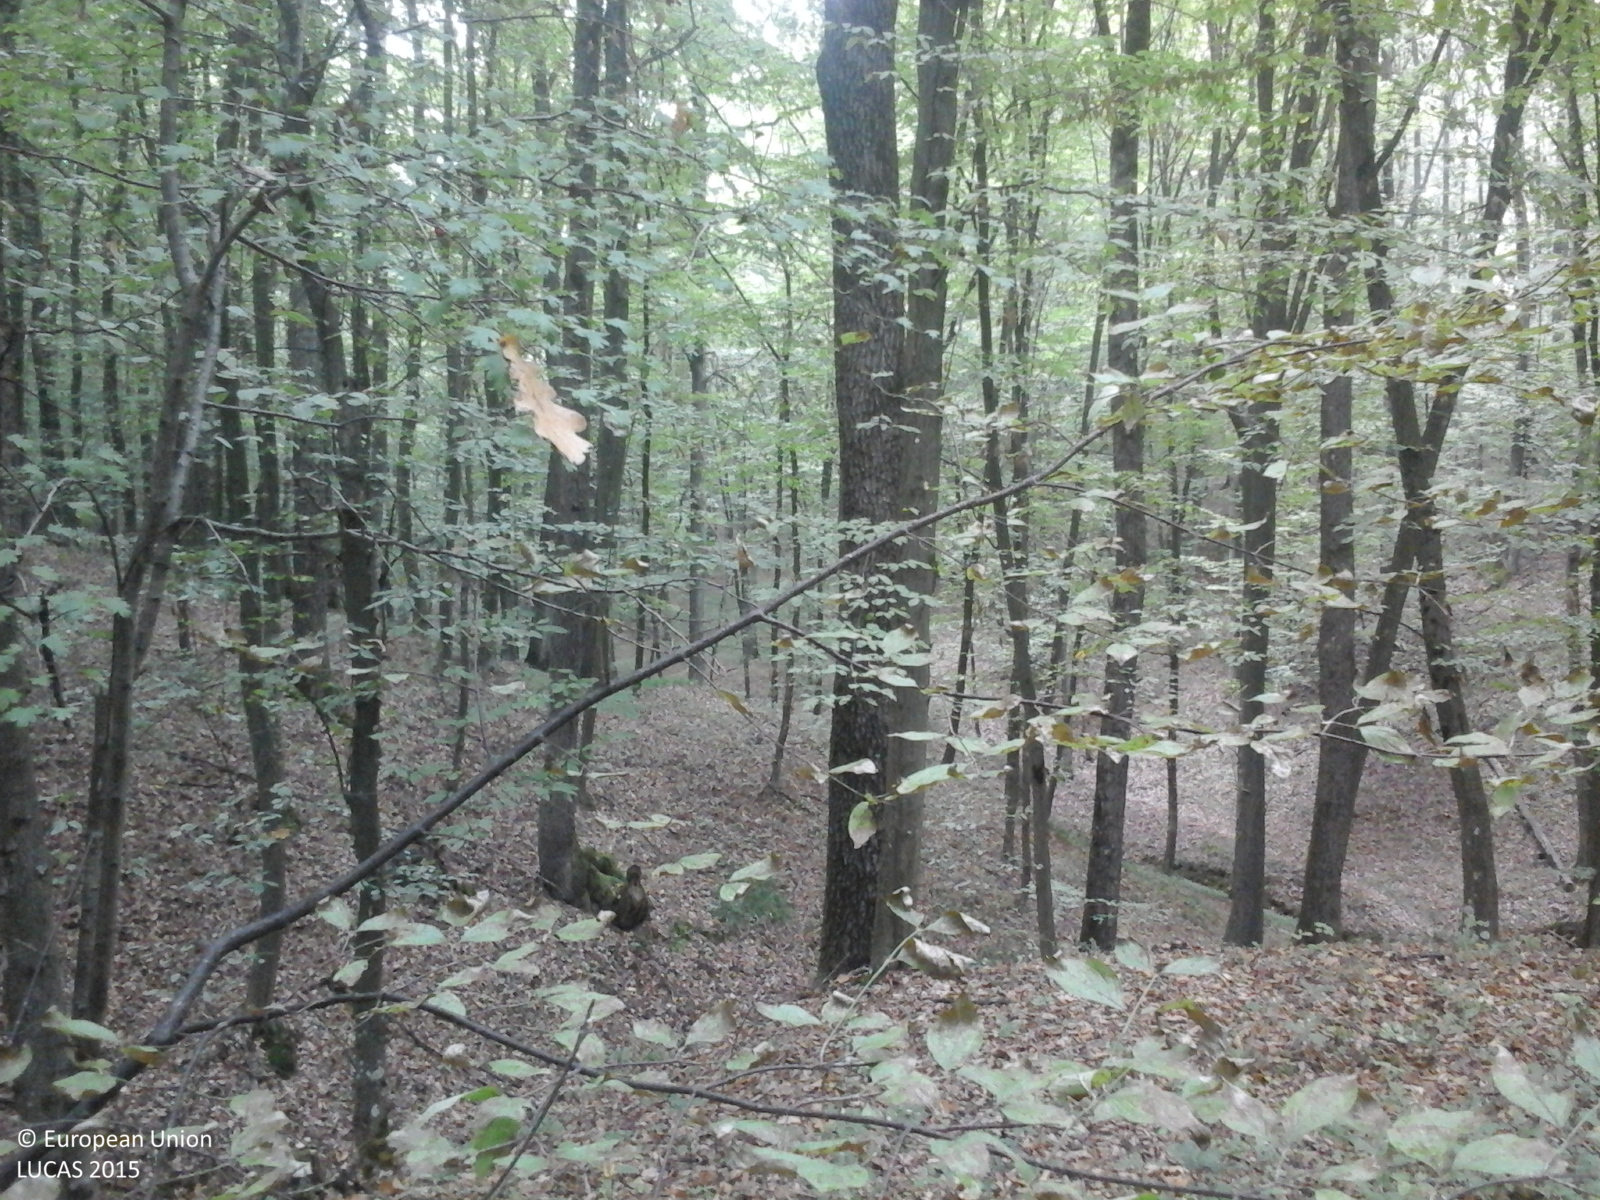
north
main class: Woodland
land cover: Broadleaved woodland
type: beech forest
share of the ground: > 75 %
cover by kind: broadleaved forest trees 100 %
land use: Forestry
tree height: > 5 m
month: September
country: RO
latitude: 44.9426
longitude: 23.2198
